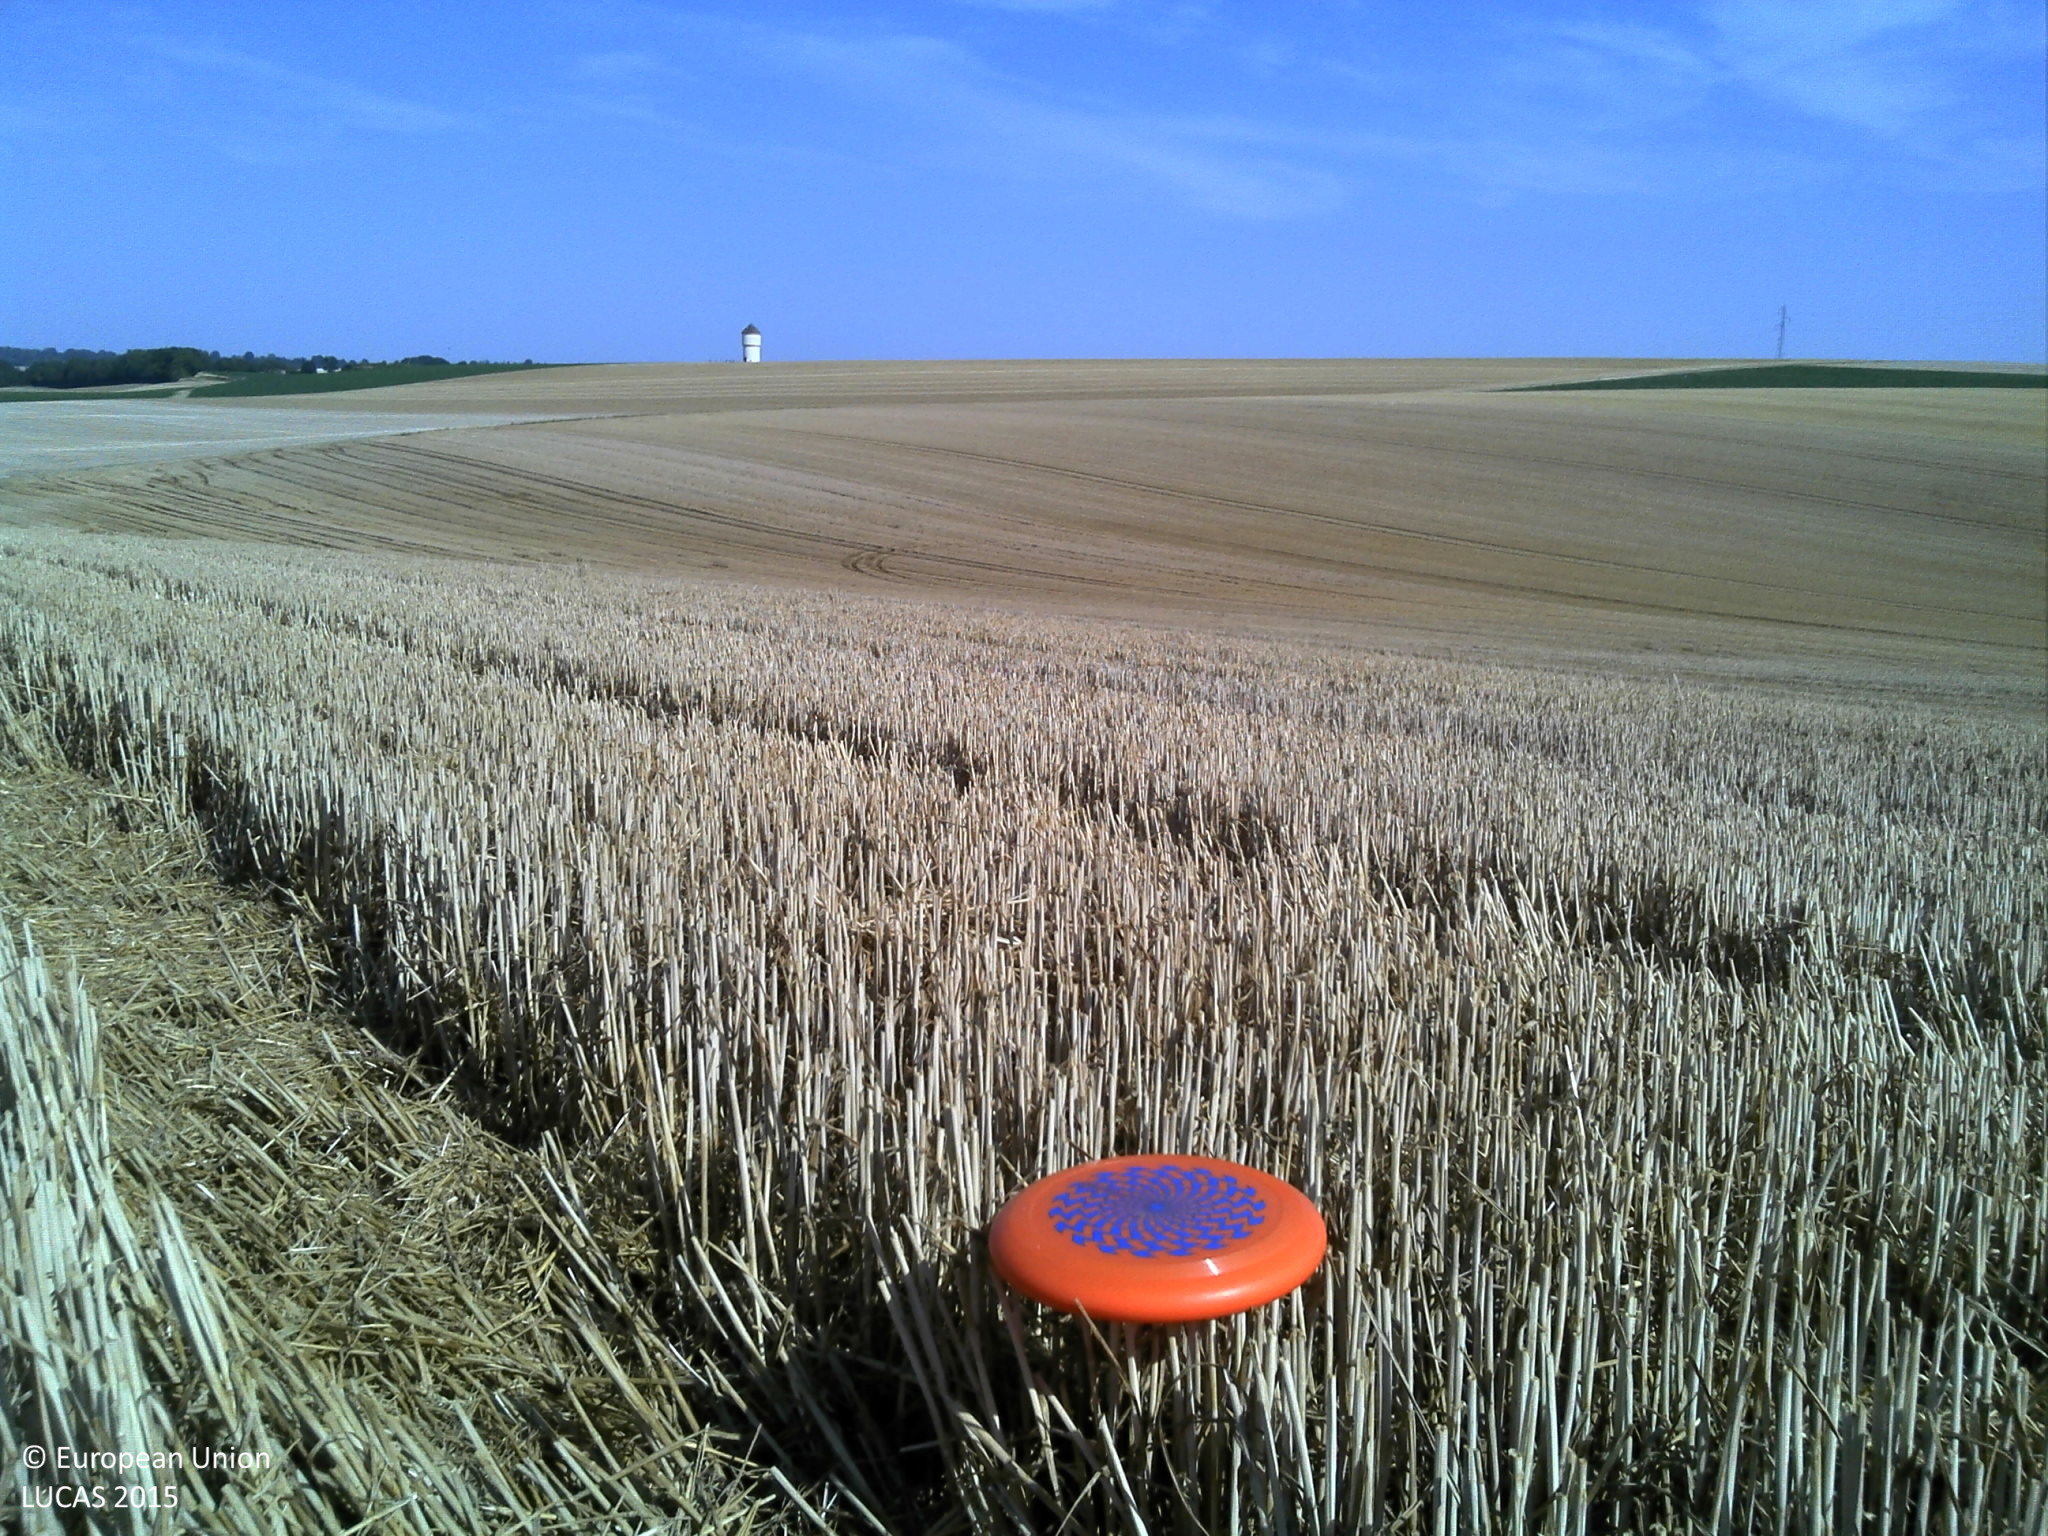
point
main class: Cropland
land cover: Common wheat
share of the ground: > 75 %
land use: Agriculture (excluding fallow land and kitchen gardens)
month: August
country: FR
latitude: 49.1069
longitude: 4.7233
